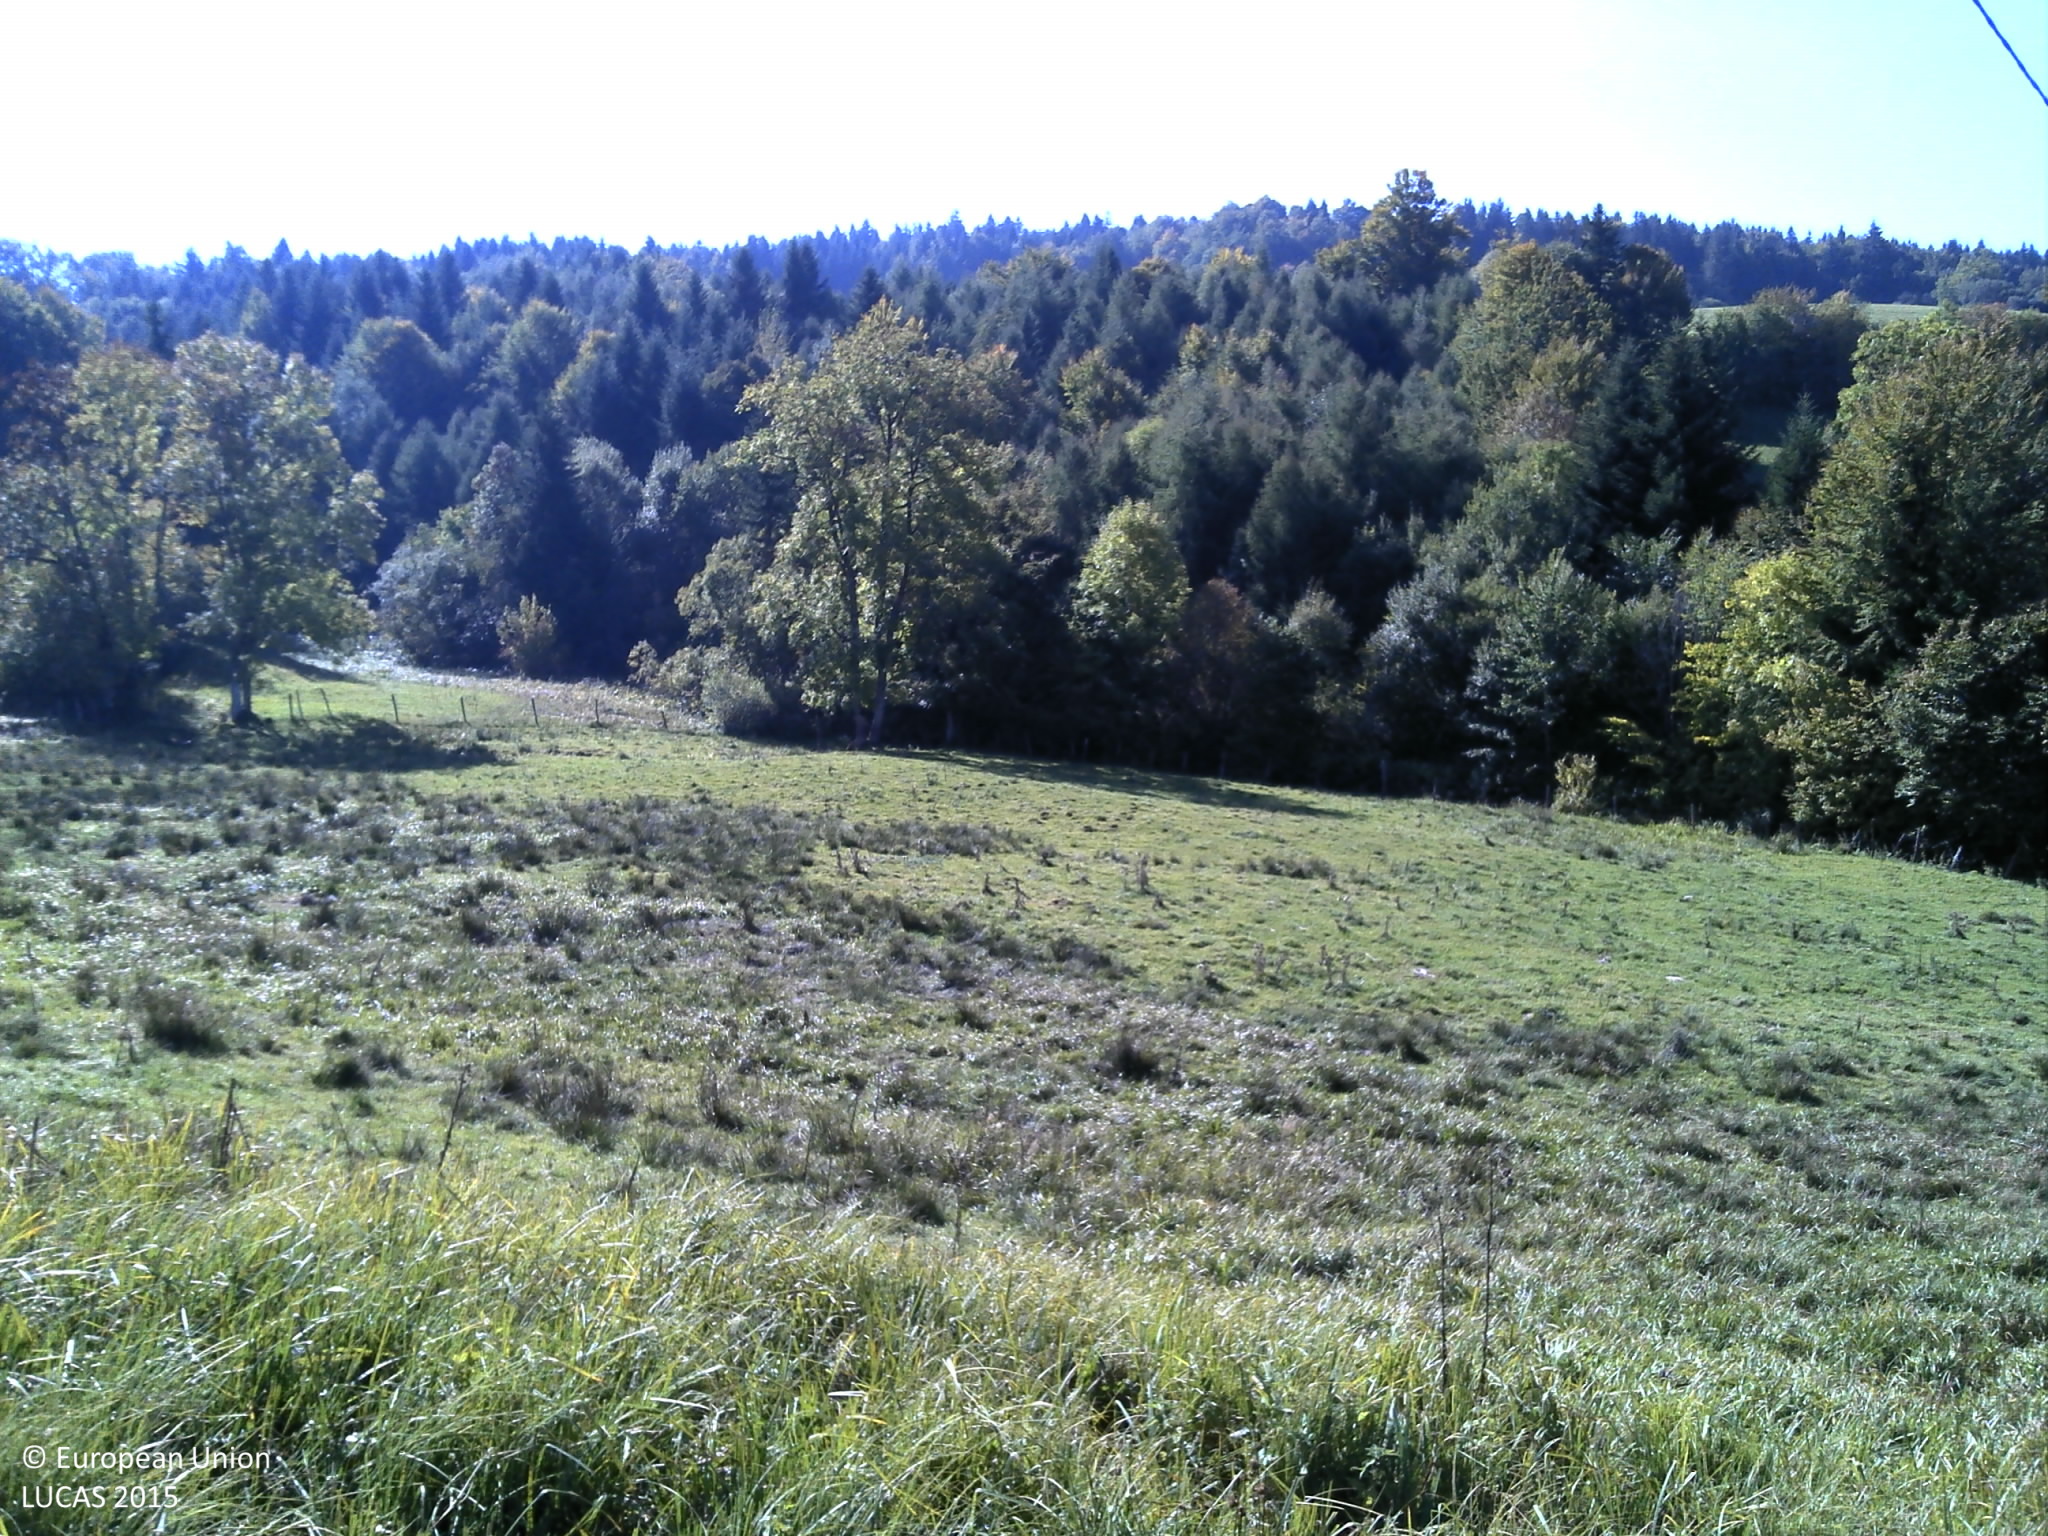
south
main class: Grassland
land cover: Grassland without tree/shrub cover
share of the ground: > 75 %
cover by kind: herbaceous plants 100 %
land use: Agriculture (excluding fallow land and kitchen gardens)
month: October
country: FR
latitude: 45.3909
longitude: 2.8858
